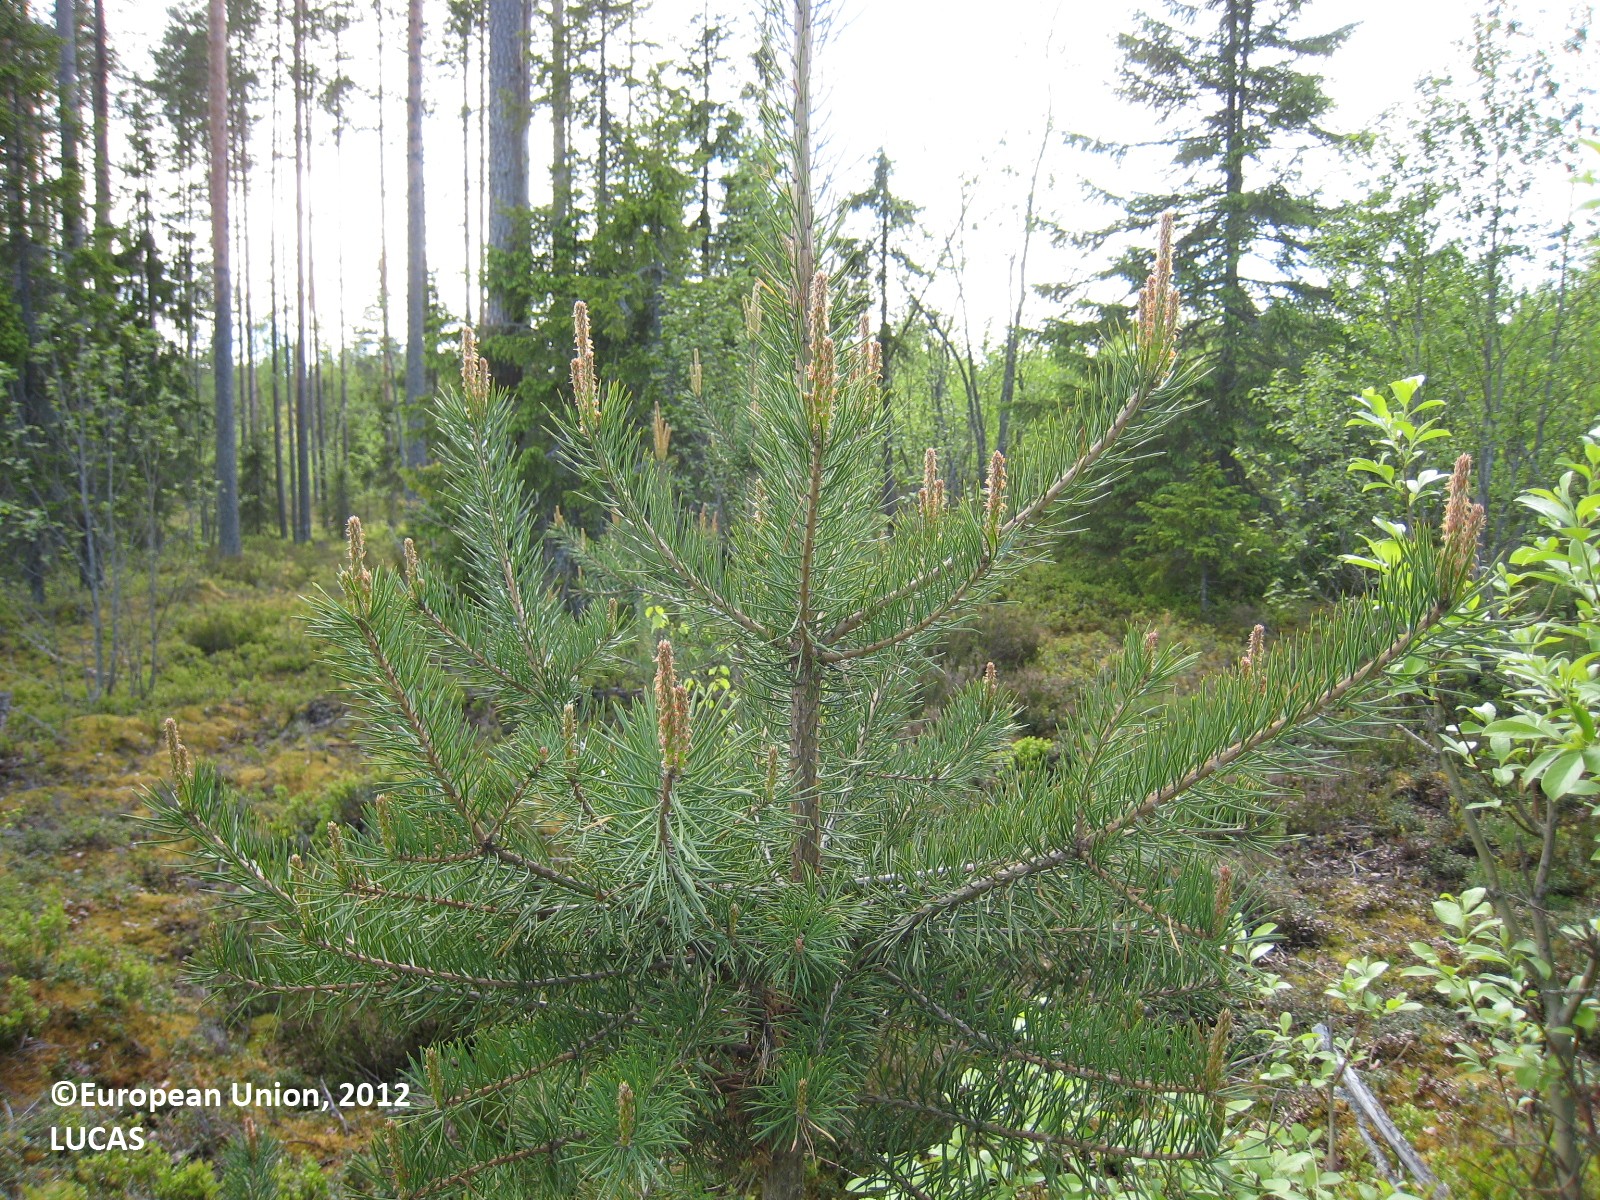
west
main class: Woodland
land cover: Pine dominated mixed woodland
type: boreal forest
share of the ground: 50 - 75 %
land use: Forestry
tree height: < 5 m
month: June
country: FI
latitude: 62.7086
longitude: 25.6550
